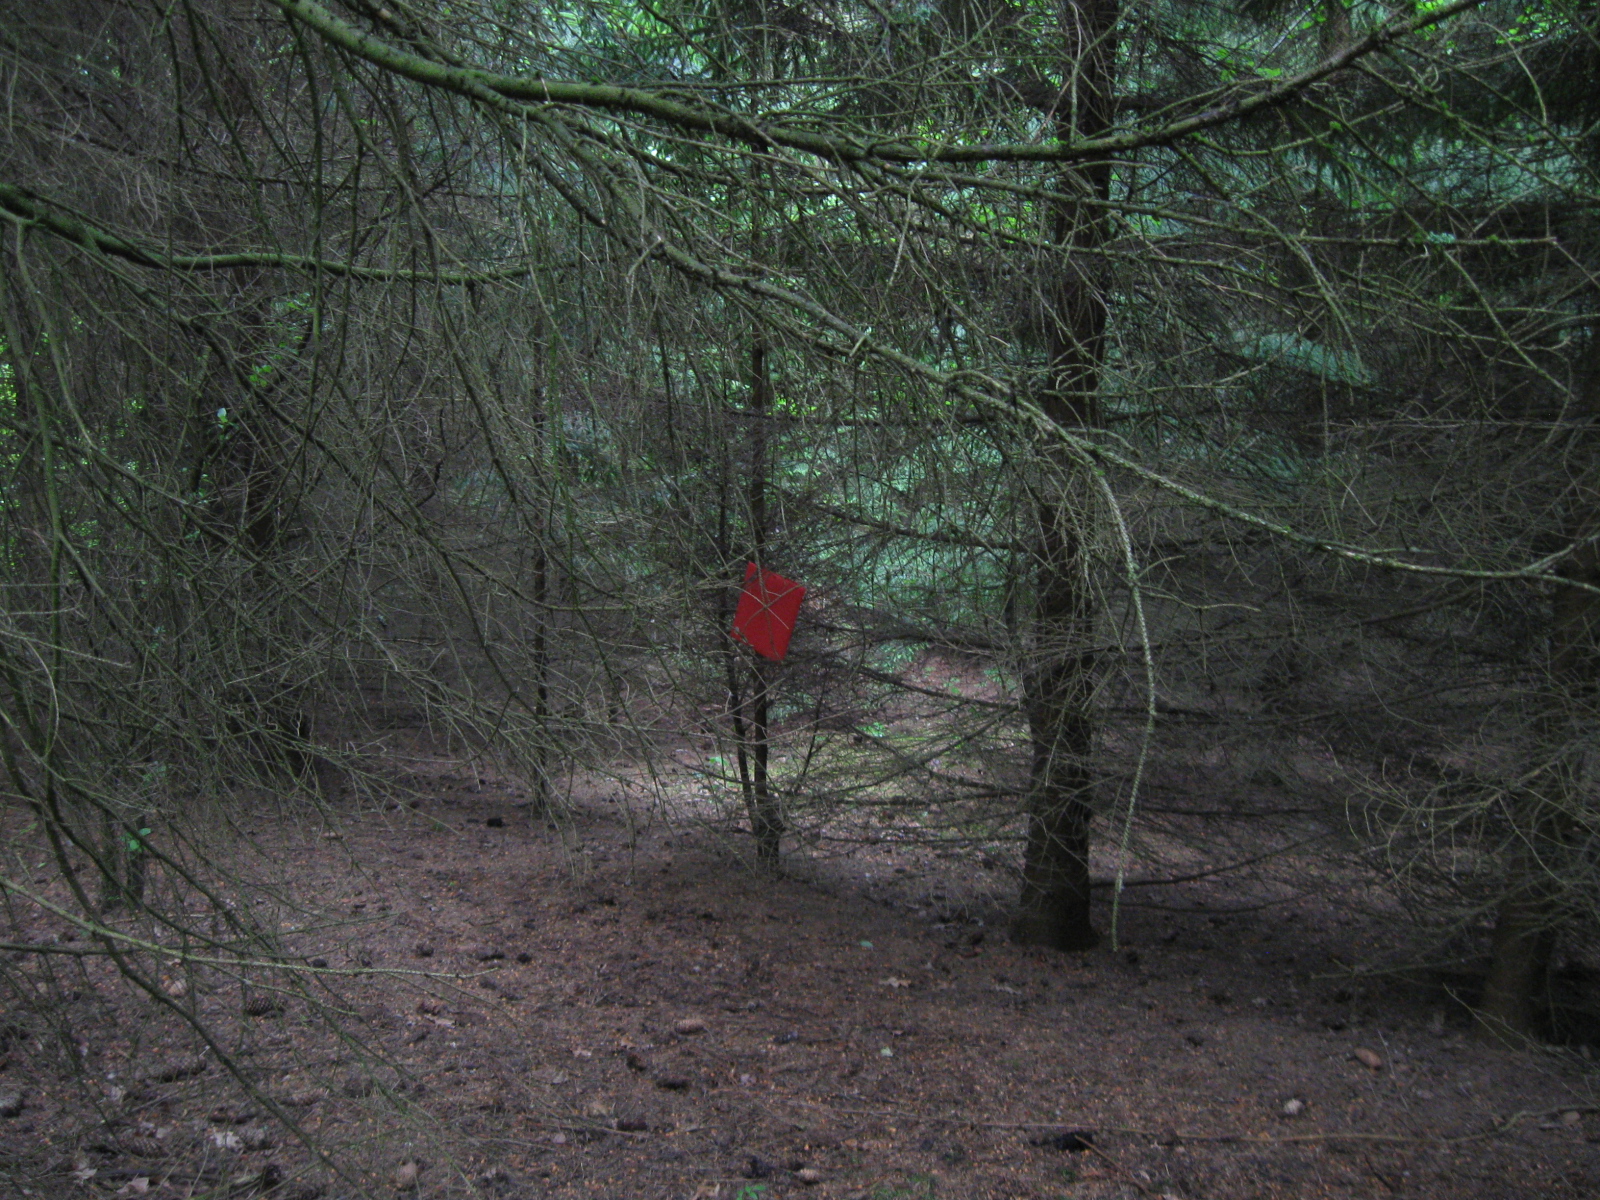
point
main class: Woodland
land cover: Spruce dominated coniferous woodland
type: hemiboreal forest and nemoral coniferous forest and mixed broadleaved-coniferous forest
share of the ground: > 75 %
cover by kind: coniferous forest trees 85 %, broadleaved forest trees 15 %
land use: Forestry
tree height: > 5 m
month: June
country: LT
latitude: 54.6025
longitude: 24.3885
